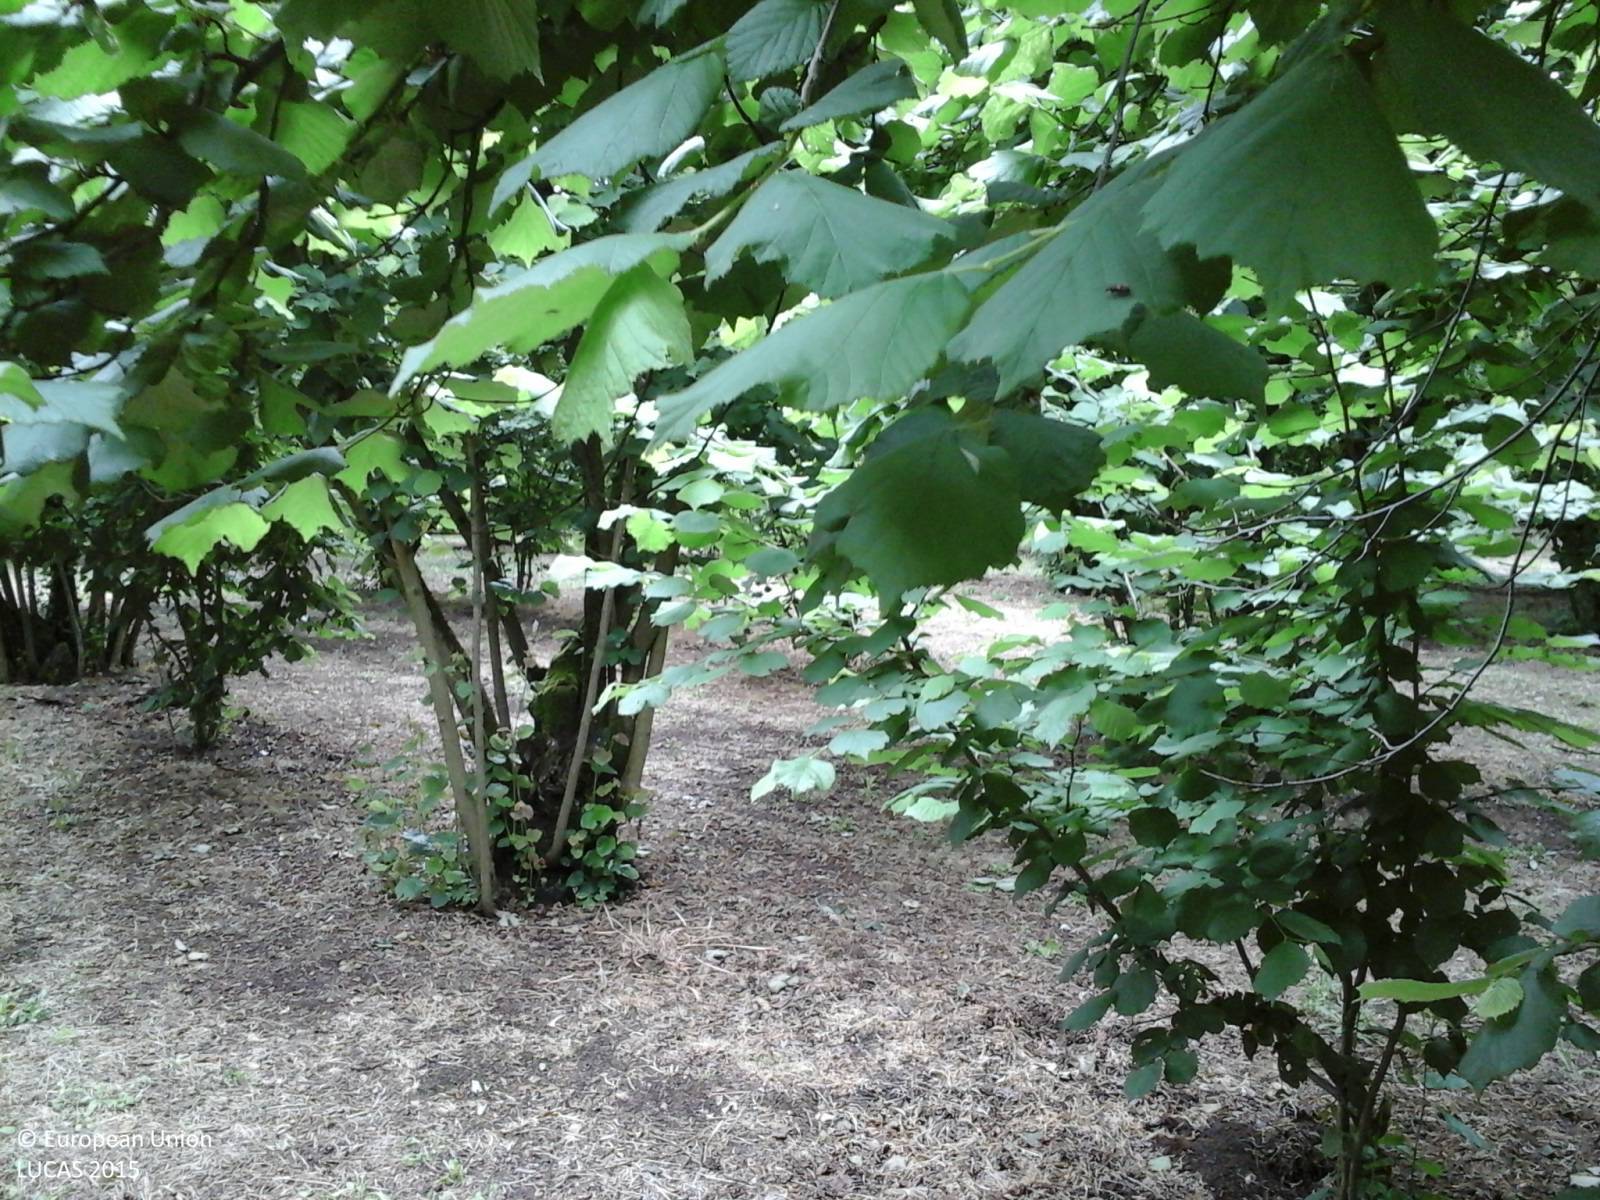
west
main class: Cropland
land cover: Nuts trees
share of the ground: > 75 %
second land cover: Spontaneously vegetated surfaces
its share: 50 - 75 %
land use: Agriculture (excluding fallow land and kitchen gardens)
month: May
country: IT
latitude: 42.3041
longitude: 12.2364
